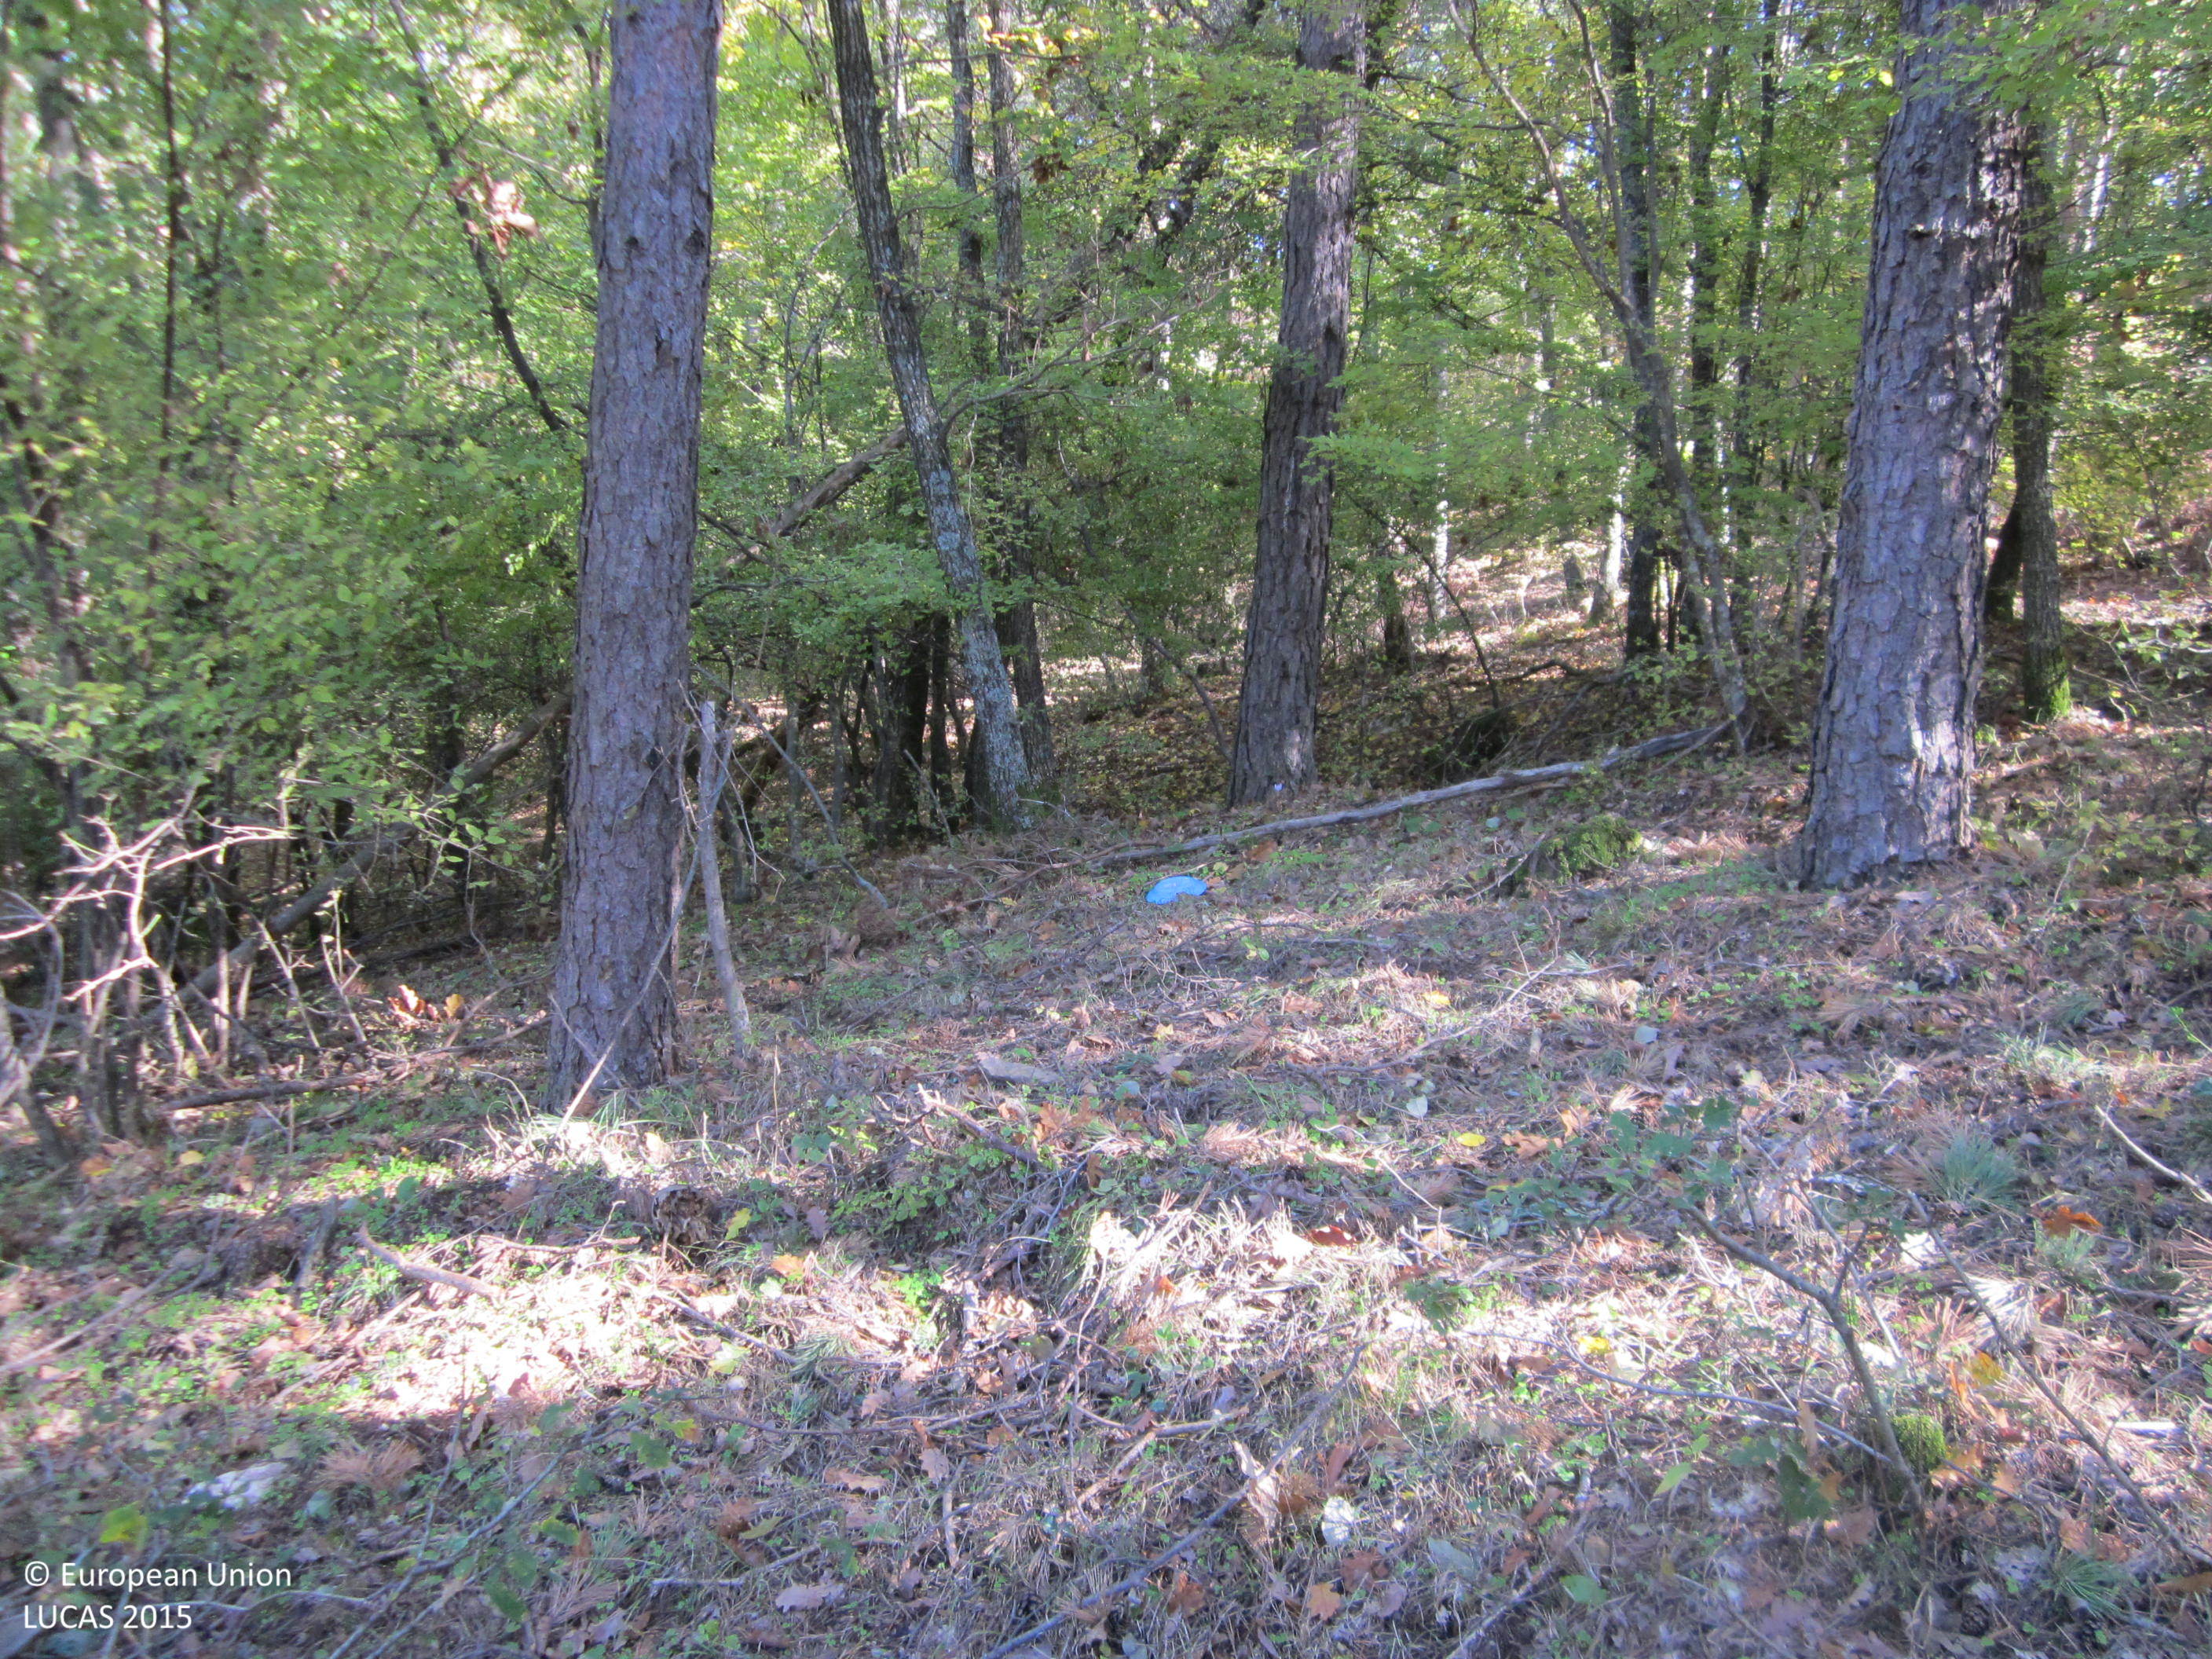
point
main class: Woodland
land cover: Pine dominated mixed woodland
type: hemiboreal forest and nemoral coniferous forest and mixed broadleaved-coniferous forest
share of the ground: > 75 %
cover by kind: coniferous forest trees 60 %, broadleaved forest trees 20 %, herbaceous plants 10 %, unconsolidated bare surface 10 %
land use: Forestry
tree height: > 5 m
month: November
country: BG
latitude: 41.4060
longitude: 25.7924
